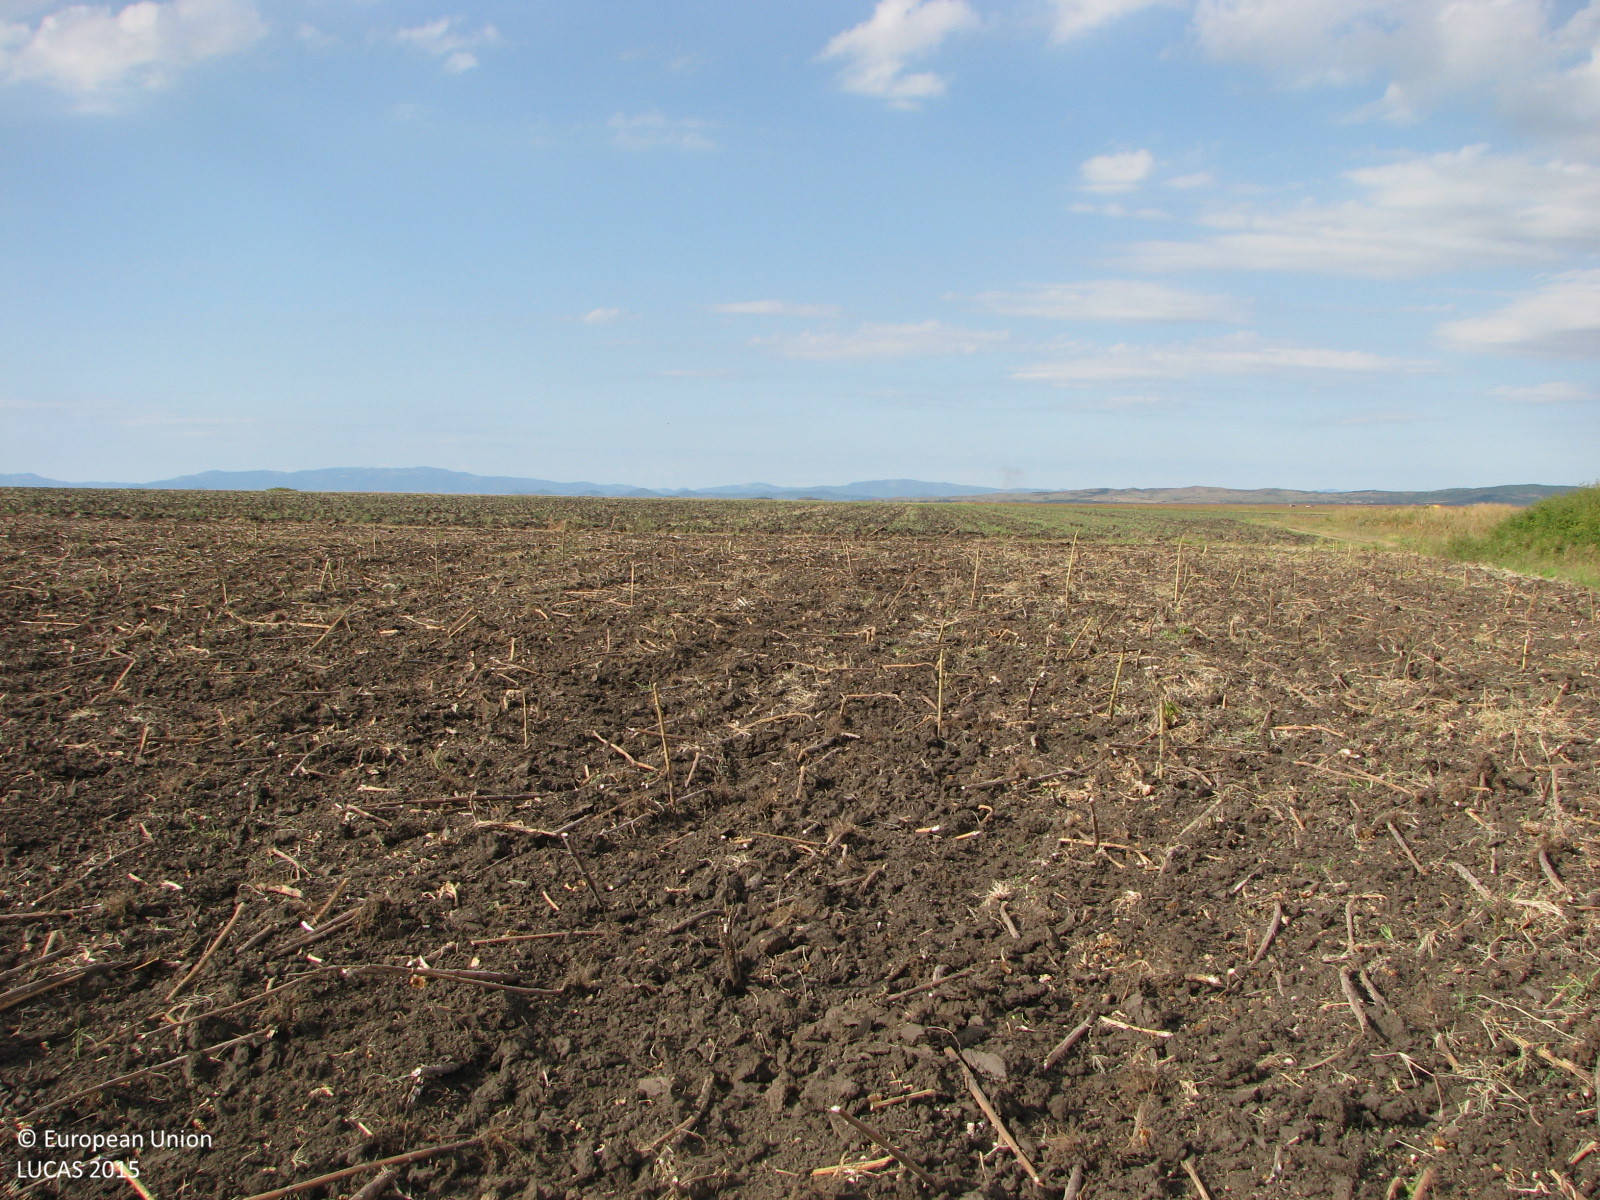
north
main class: Cropland
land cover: Sunflower
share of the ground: < 10 %
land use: Agriculture (excluding fallow land and kitchen gardens)
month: September
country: BG
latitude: 42.3222
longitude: 26.0358
